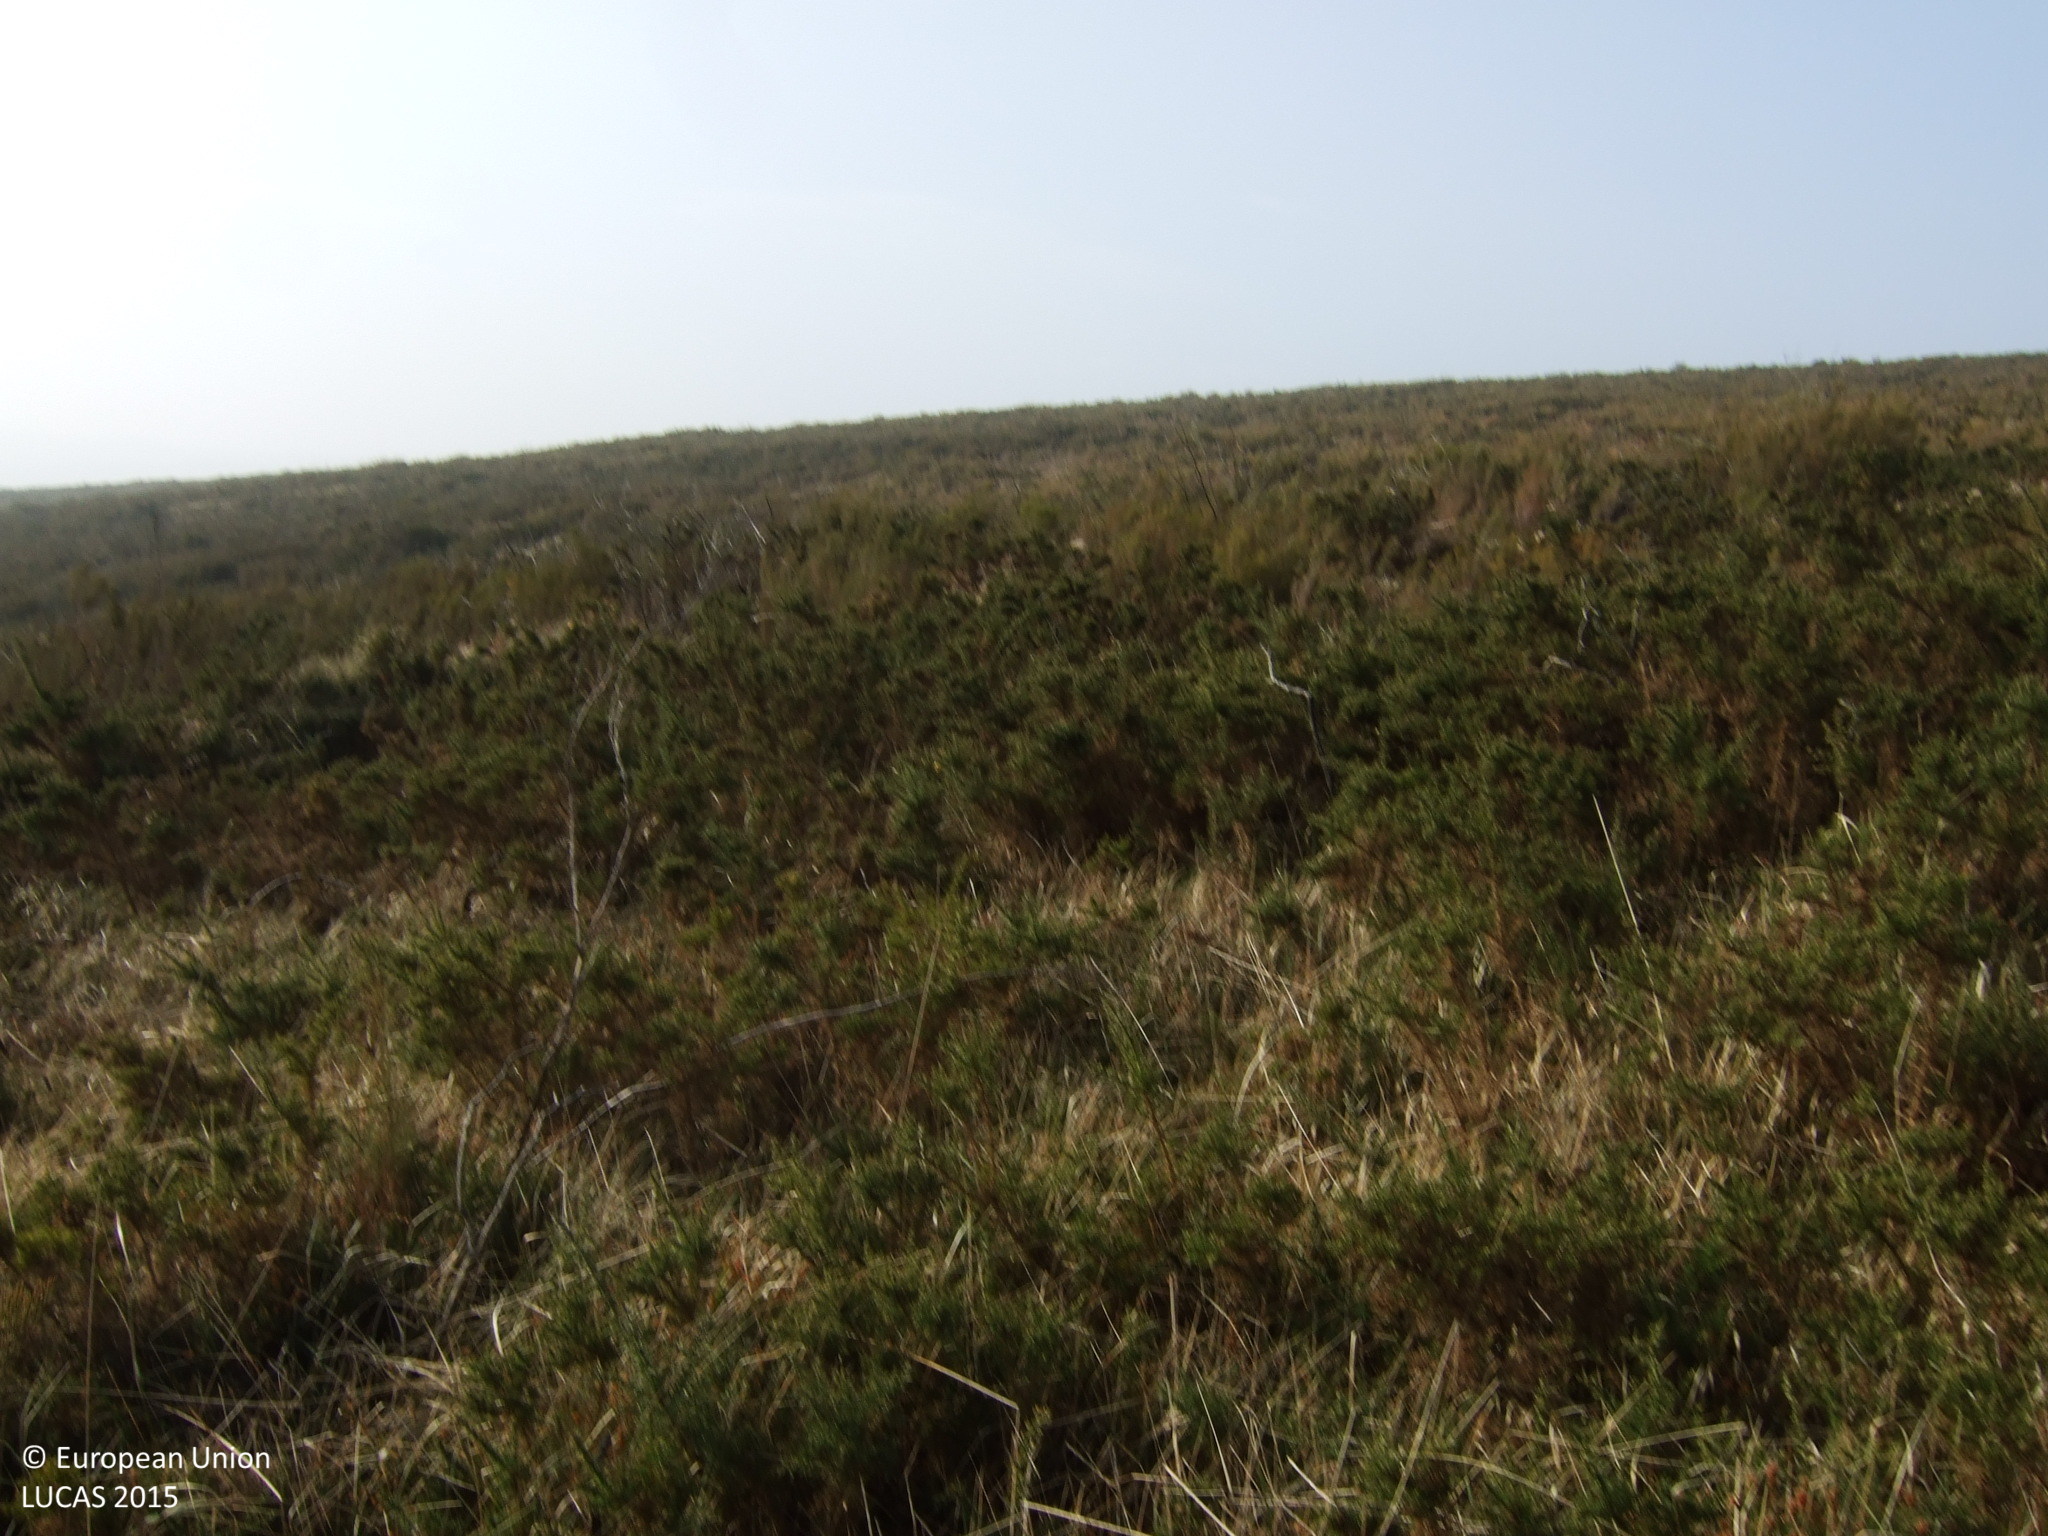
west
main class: Shrubland
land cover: Shrubland without tree cover
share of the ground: > 75 %
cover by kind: shrubs 100 %
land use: Semi-natural and natural areas not in use
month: March
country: ES
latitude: 42.9020
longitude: -7.9308
